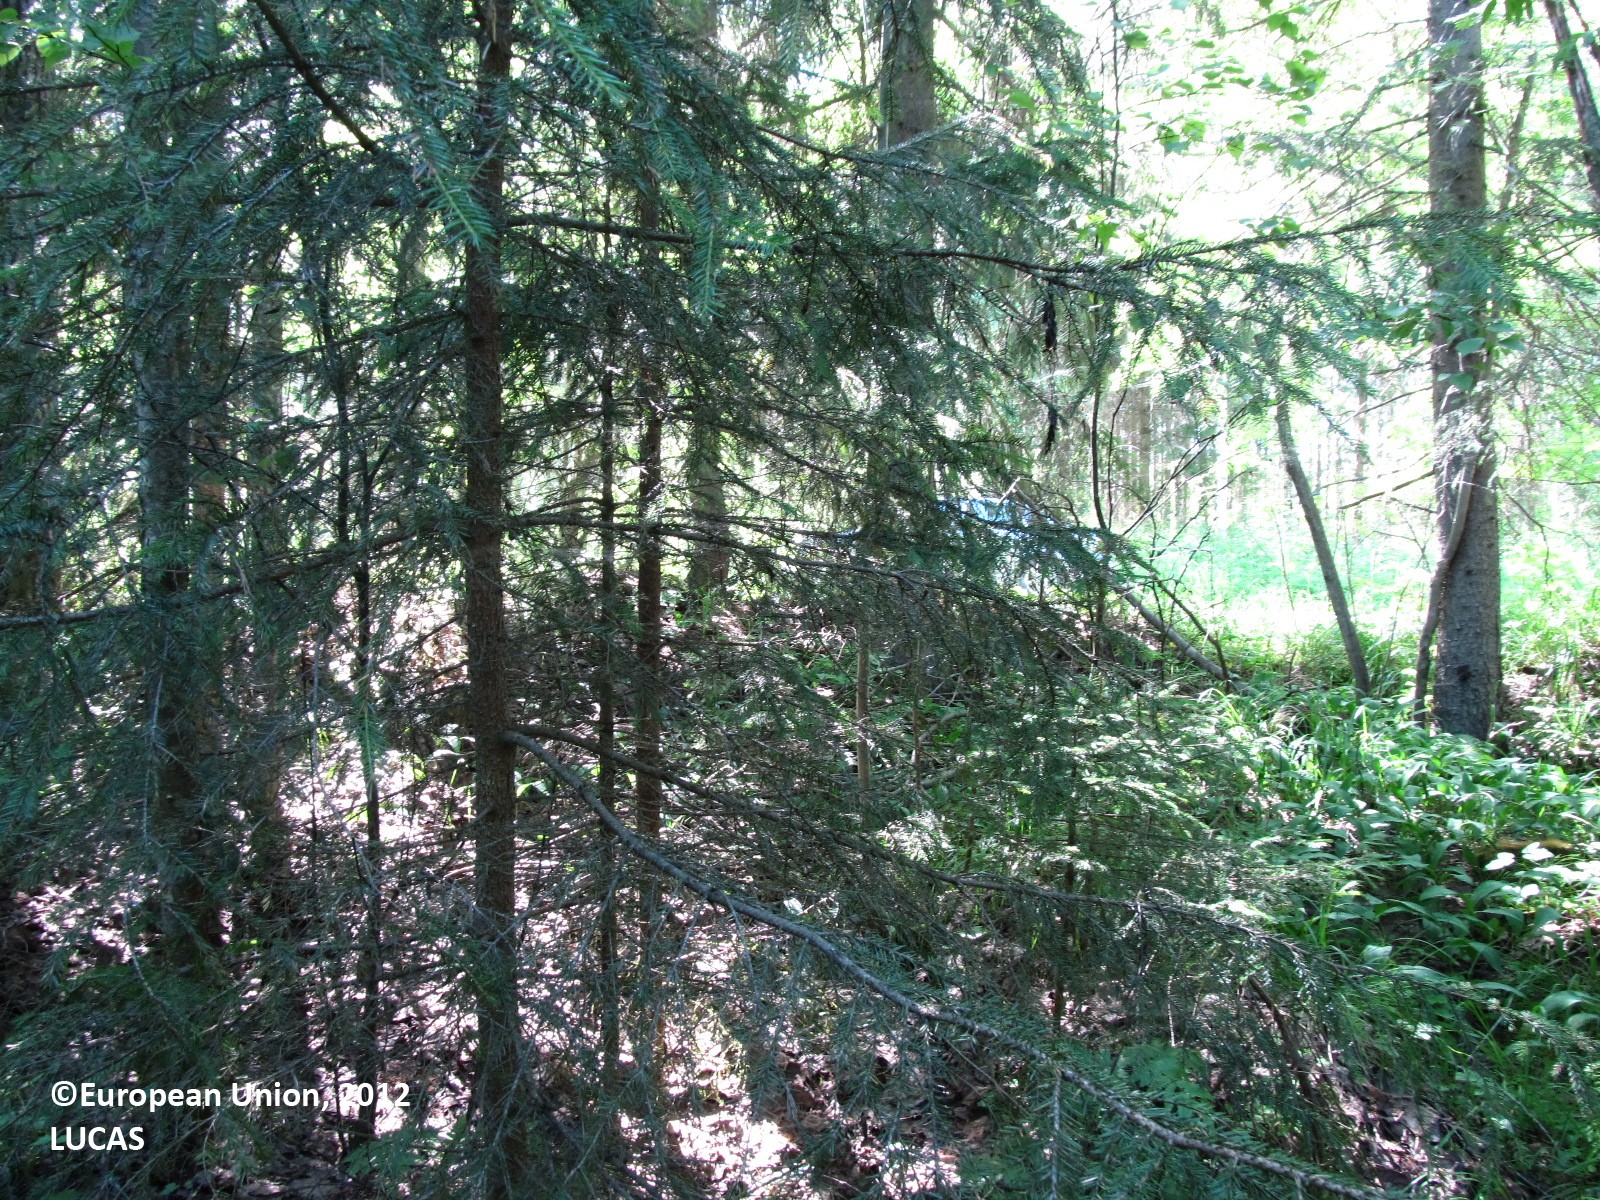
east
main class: Woodland
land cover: Spruce dominated mixed woodland
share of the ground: 50 - 75 %
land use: Forestry
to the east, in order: Spruce dominated mixed woodland; Ditches and canals; Spruce dominated mixed woodland; Spruce dominated coniferous woodland; Pine dominated mixed woodland
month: July
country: FI
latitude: 62.2484
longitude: 29.2321
